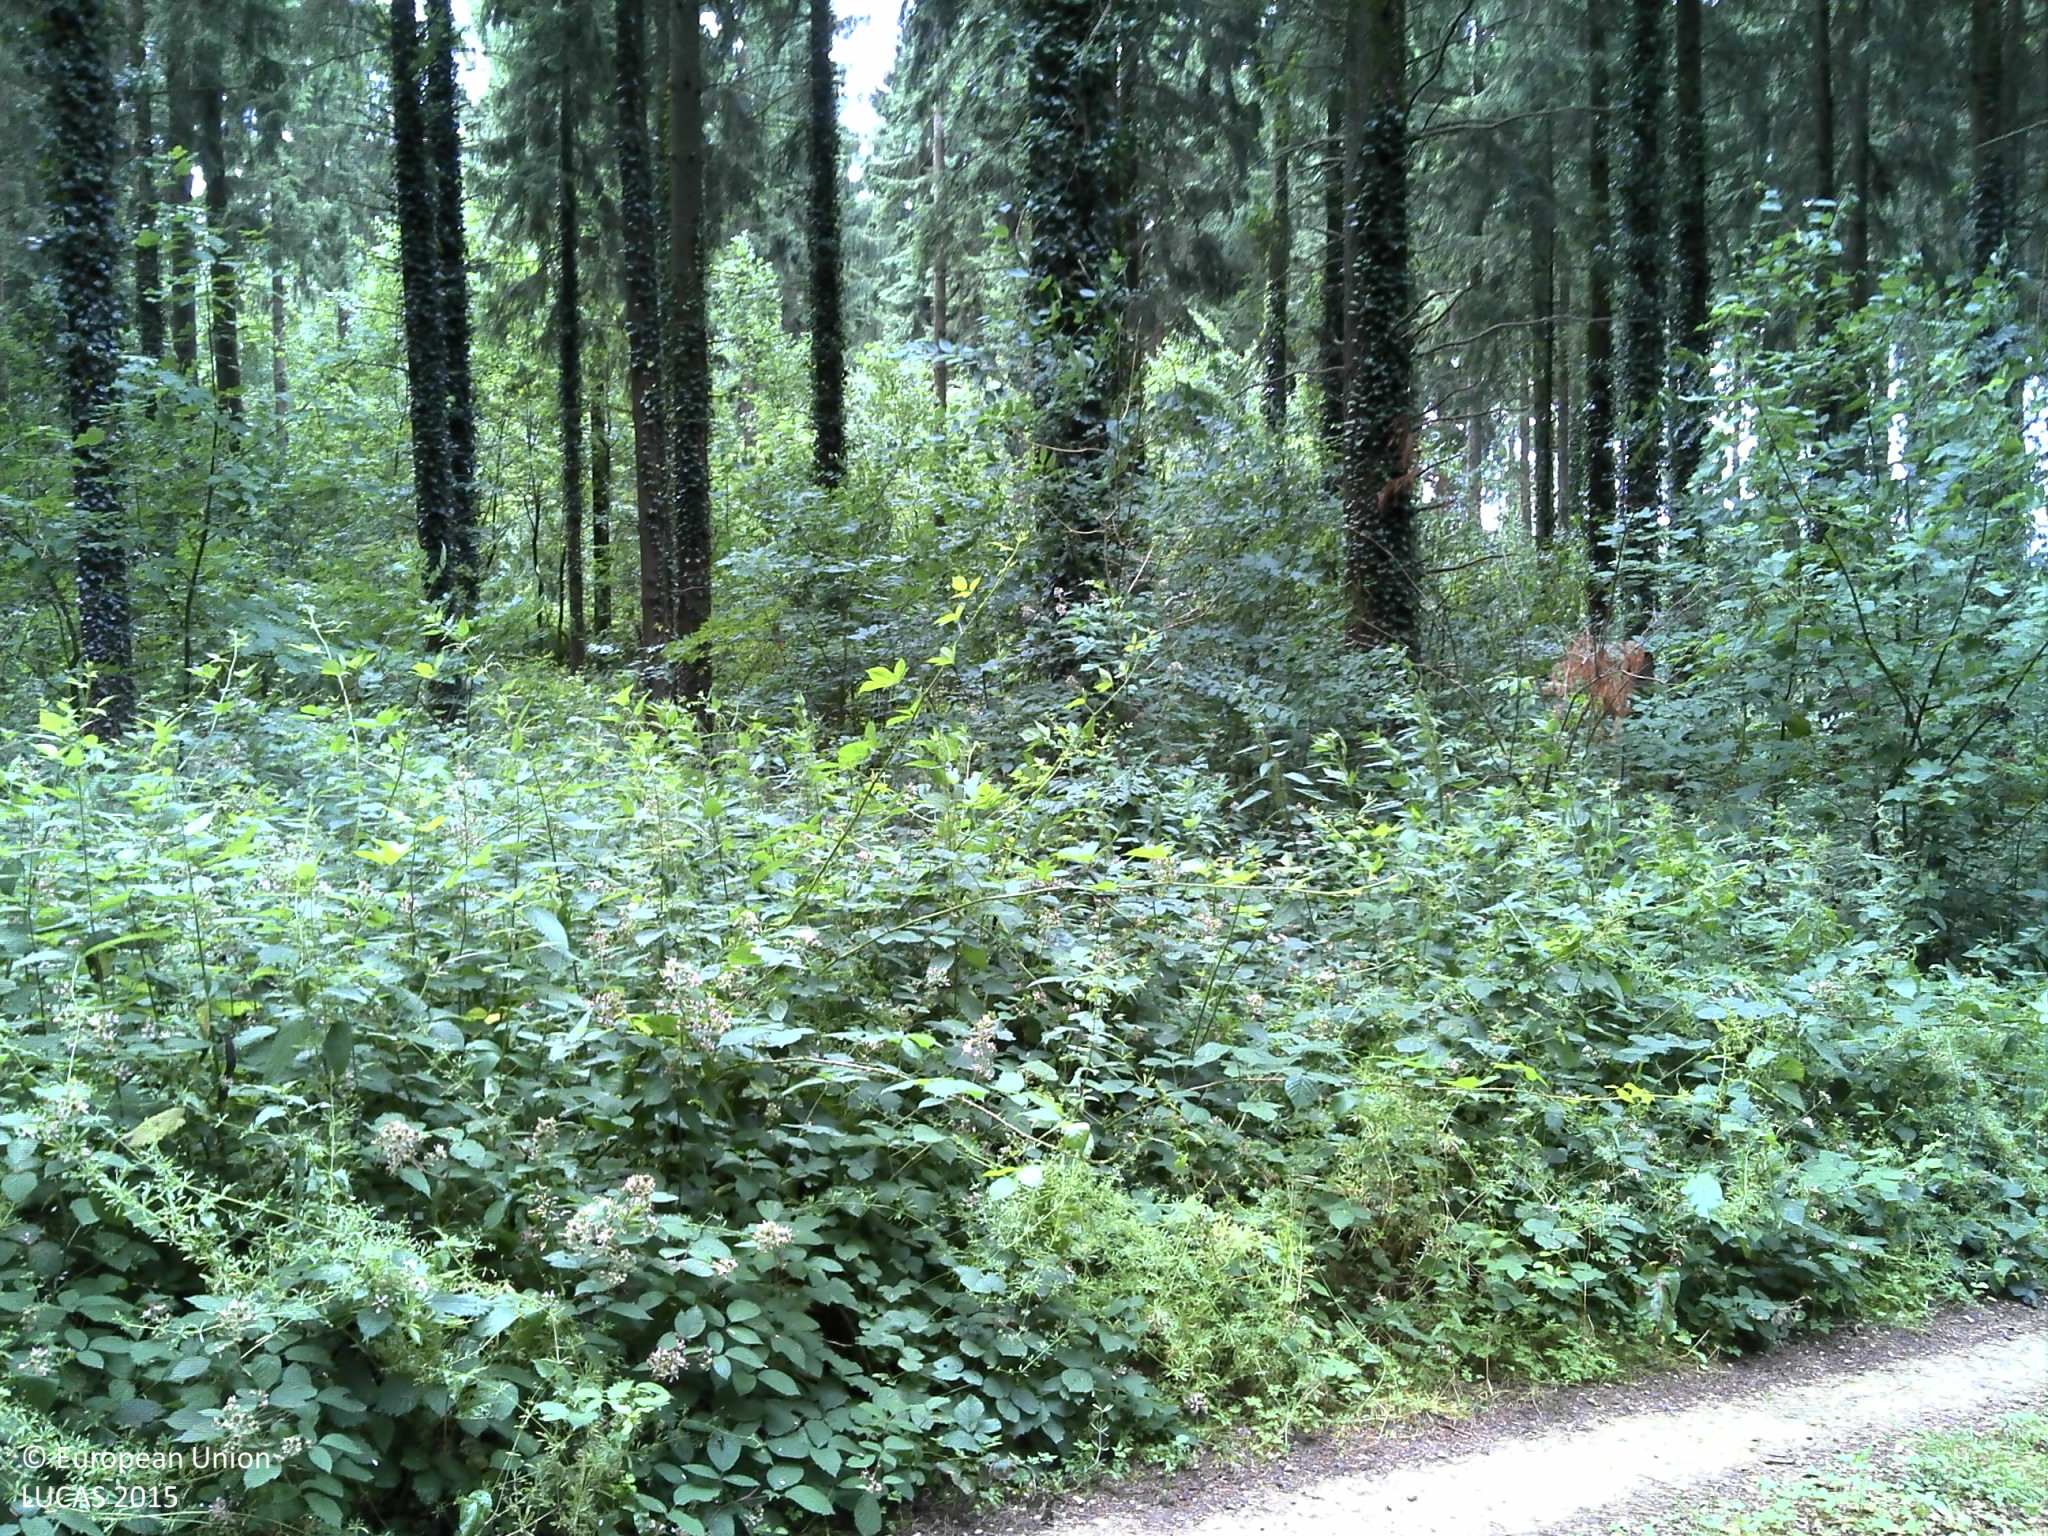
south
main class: Woodland
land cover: Spruce dominated coniferous woodland
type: exotic forest
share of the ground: > 75 %
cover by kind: coniferous forest trees 75 %, herbaceous plants 20 %, broadleaved forest trees 5 %
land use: Forestry
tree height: > 5 m
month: July
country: LU
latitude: 49.4493
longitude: 6.0406
